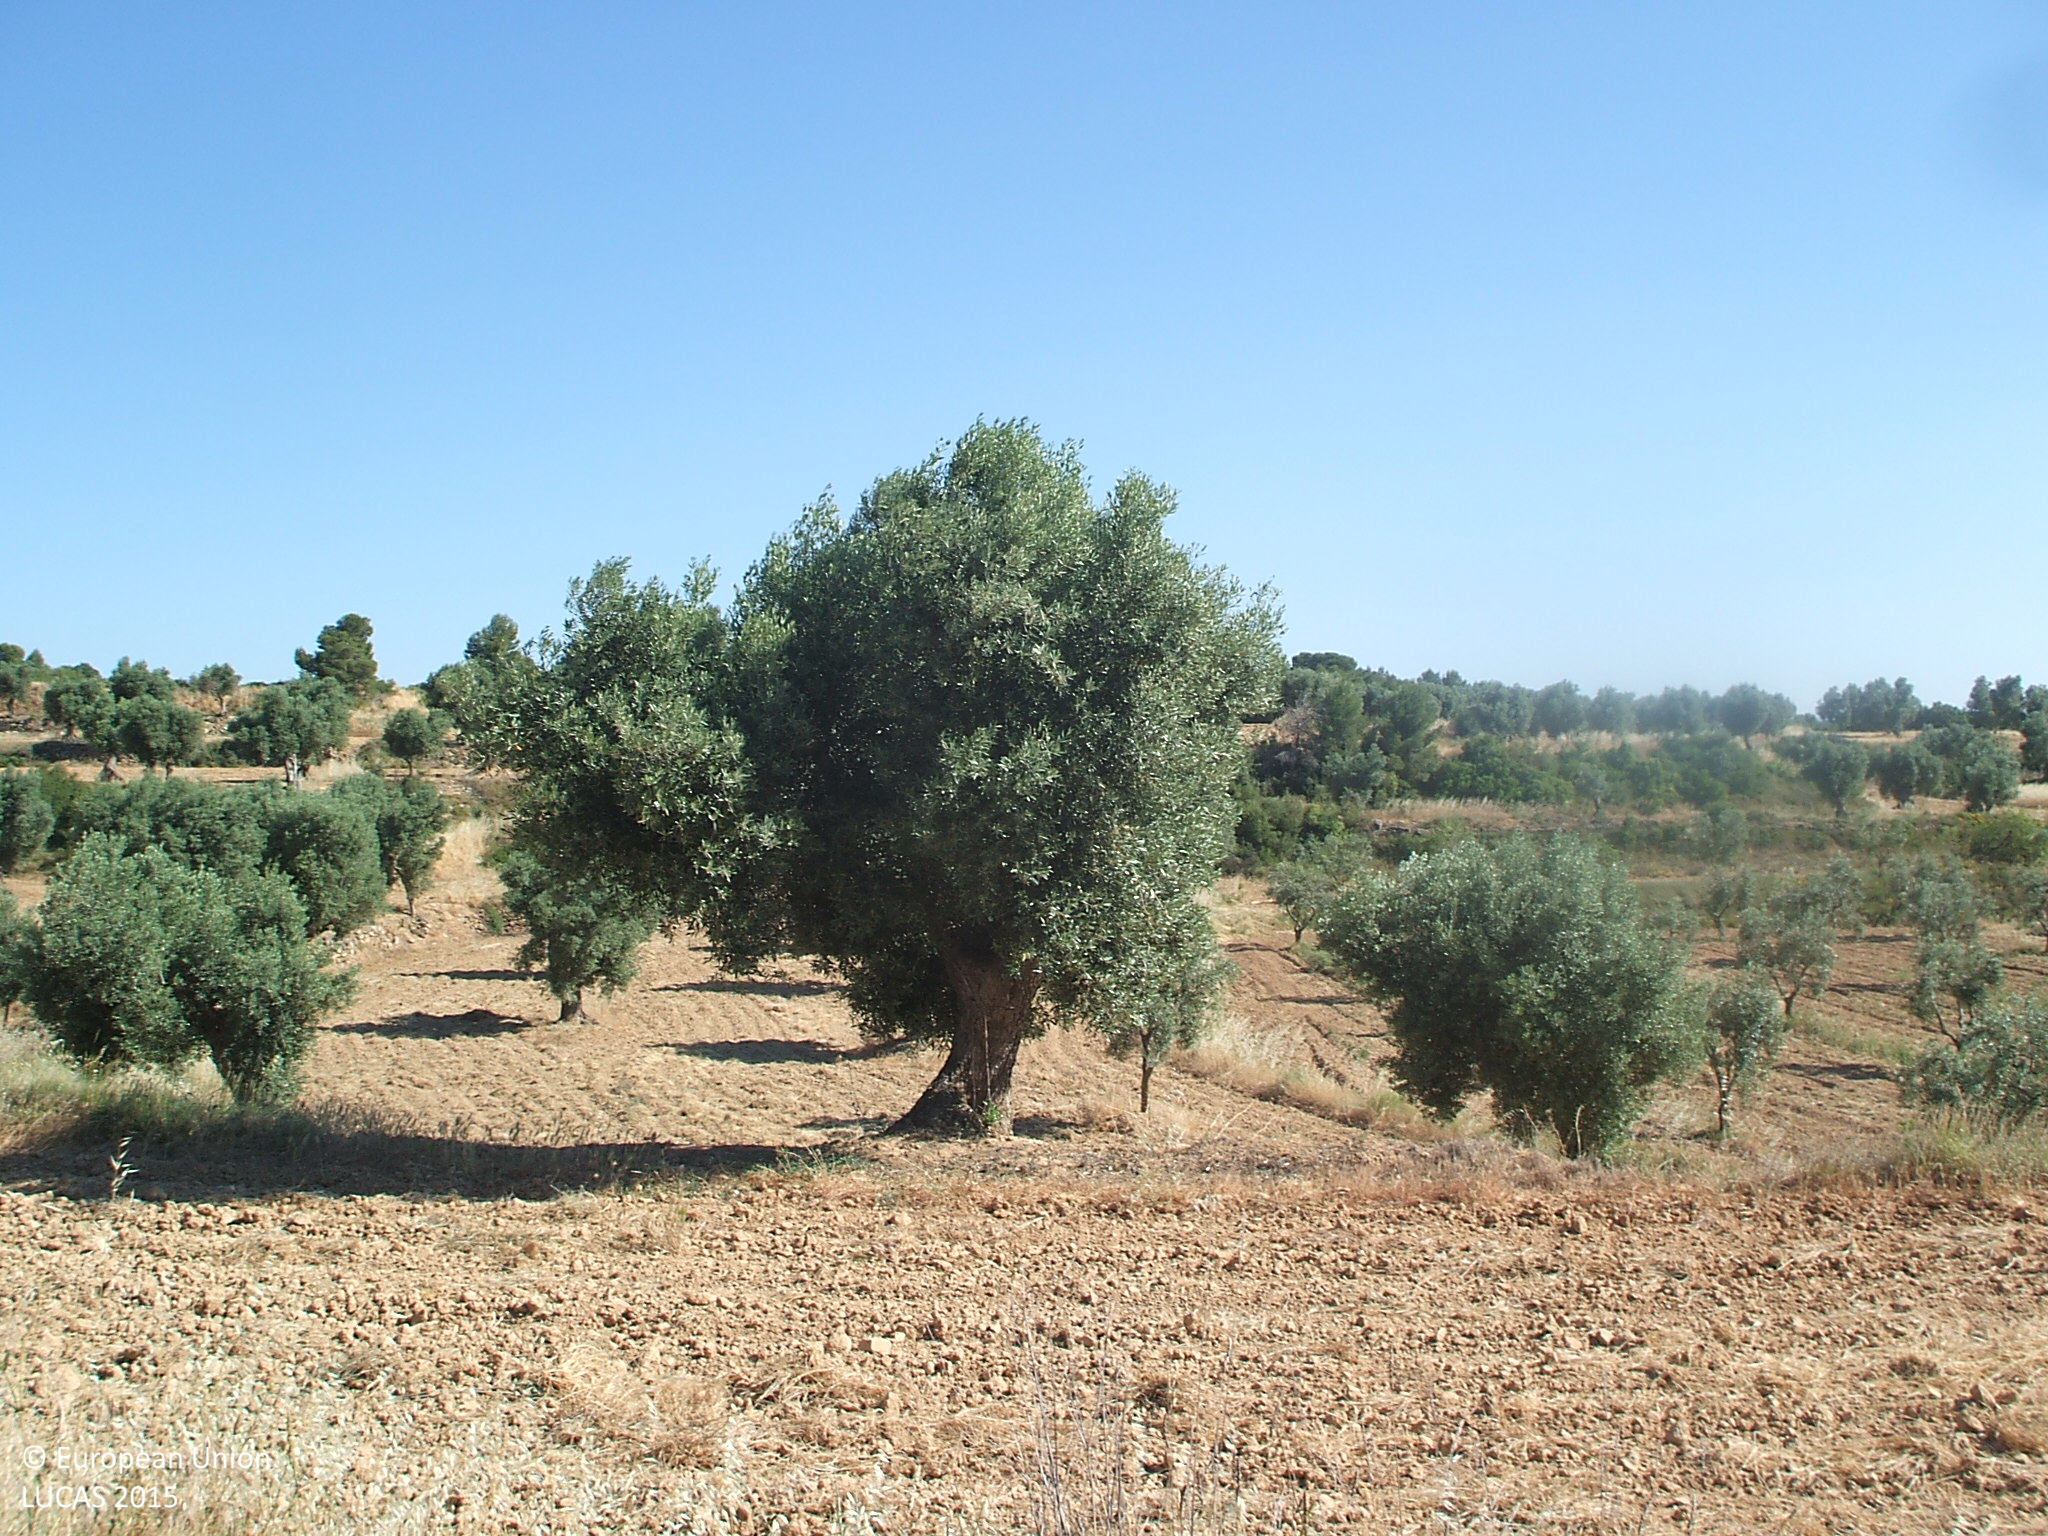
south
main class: Cropland
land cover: Olive groves
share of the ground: 10 - 25 %
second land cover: Other bare soil
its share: > 75 %
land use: Agriculture (excluding fallow land and kitchen gardens)
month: June
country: ES
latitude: 41.0094
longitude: 0.1573
